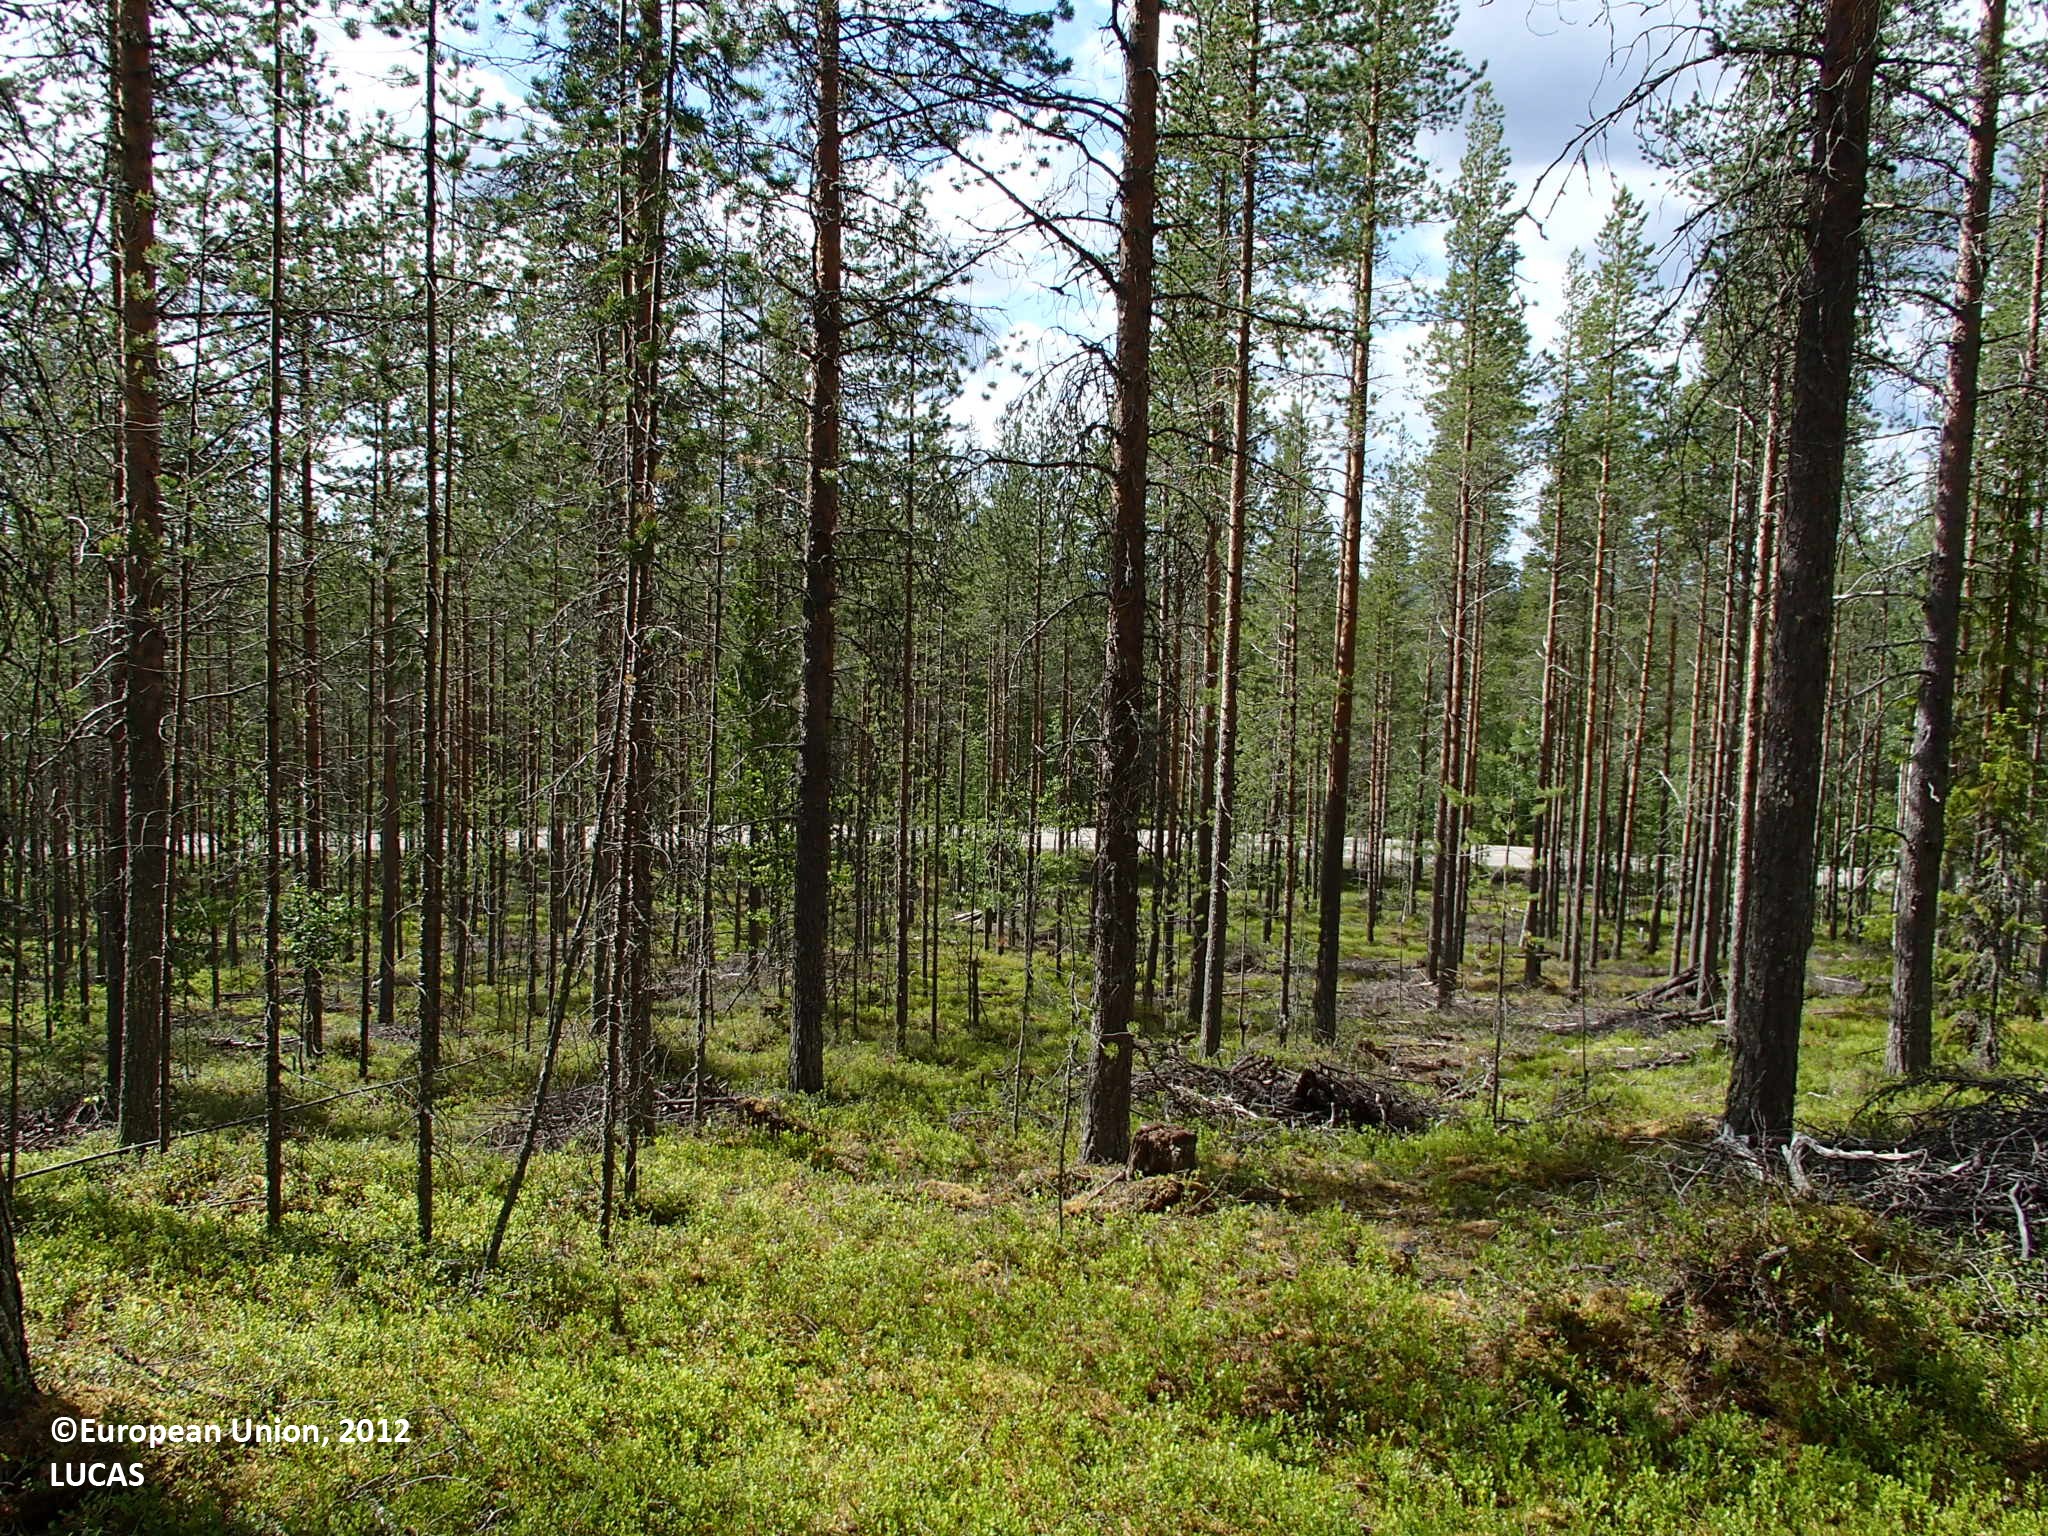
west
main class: Woodland
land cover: Pine dominated coniferous woodland
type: boreal forest
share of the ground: 50 - 75 %
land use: Forestry
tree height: > 5 m
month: June
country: FI
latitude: 66.5696
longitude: 27.2567
